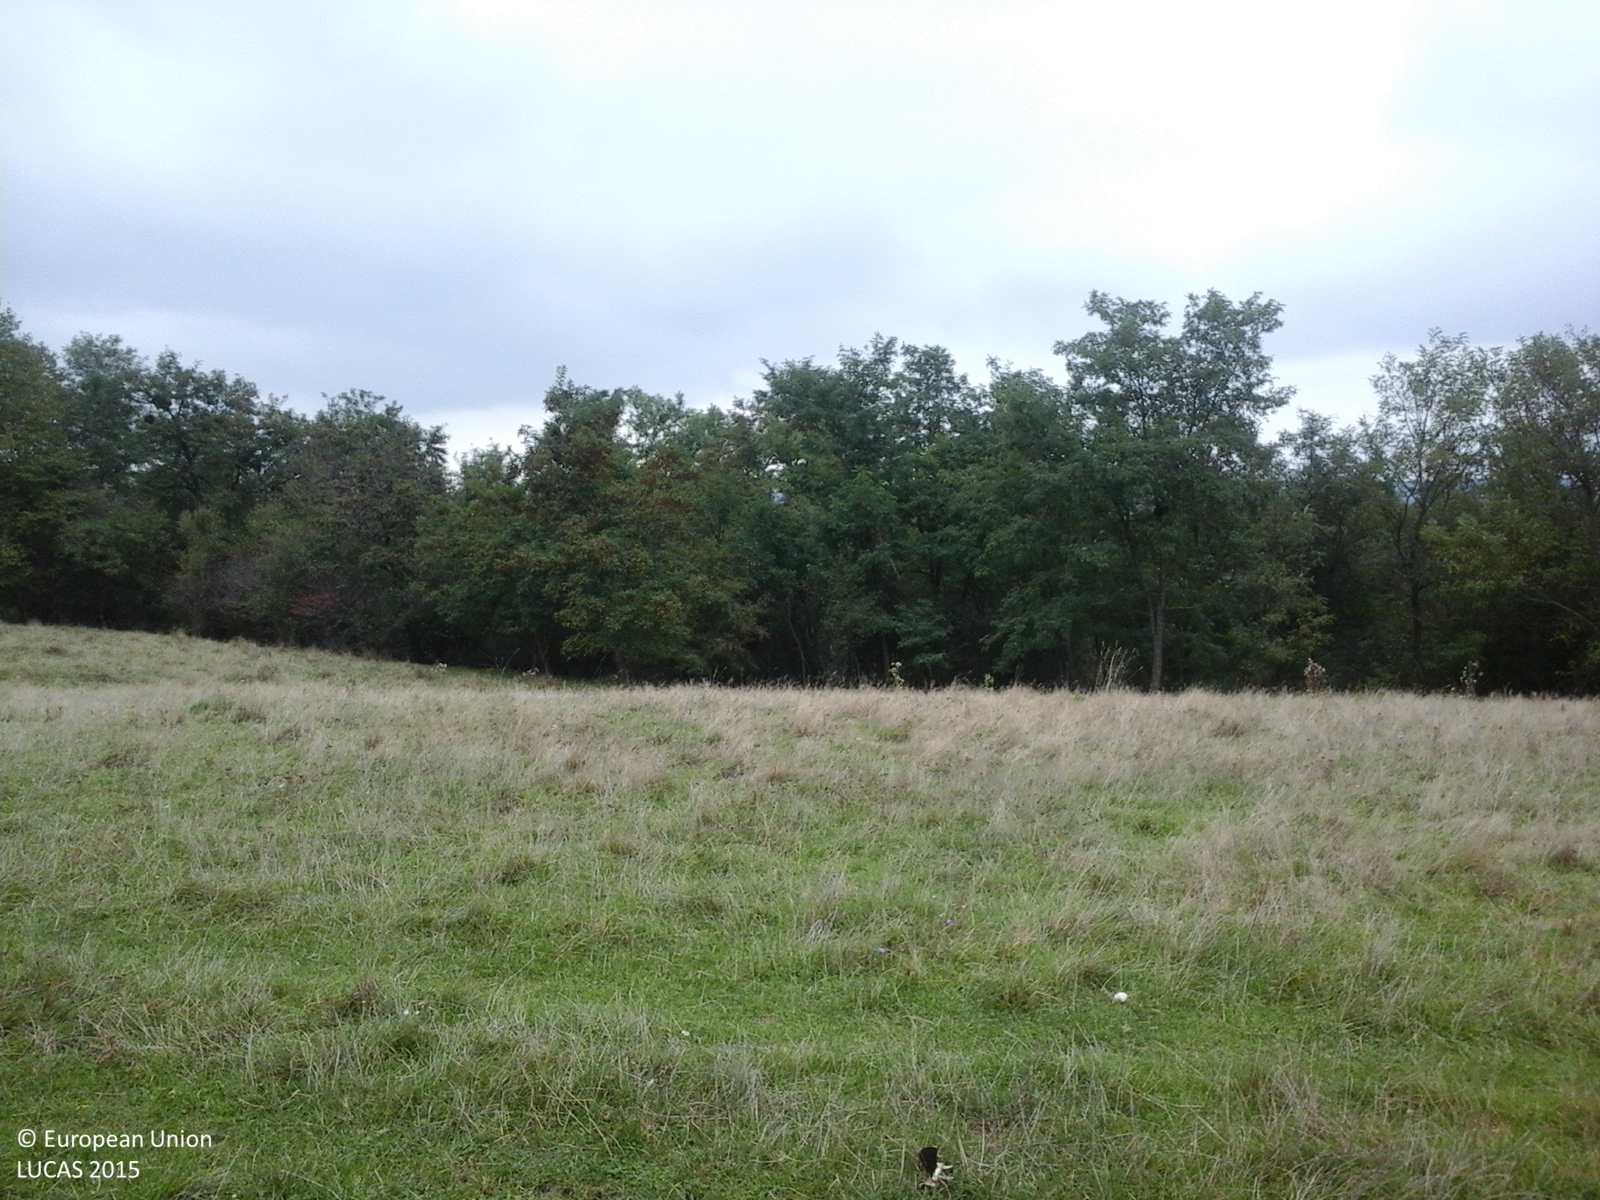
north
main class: Grassland
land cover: Grassland without tree/shrub cover
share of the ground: > 75 %
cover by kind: herbaceous plants 100 %
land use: Agriculture (excluding fallow land and kitchen gardens)
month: October
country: RO
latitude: 46.0408
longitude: 25.0985
